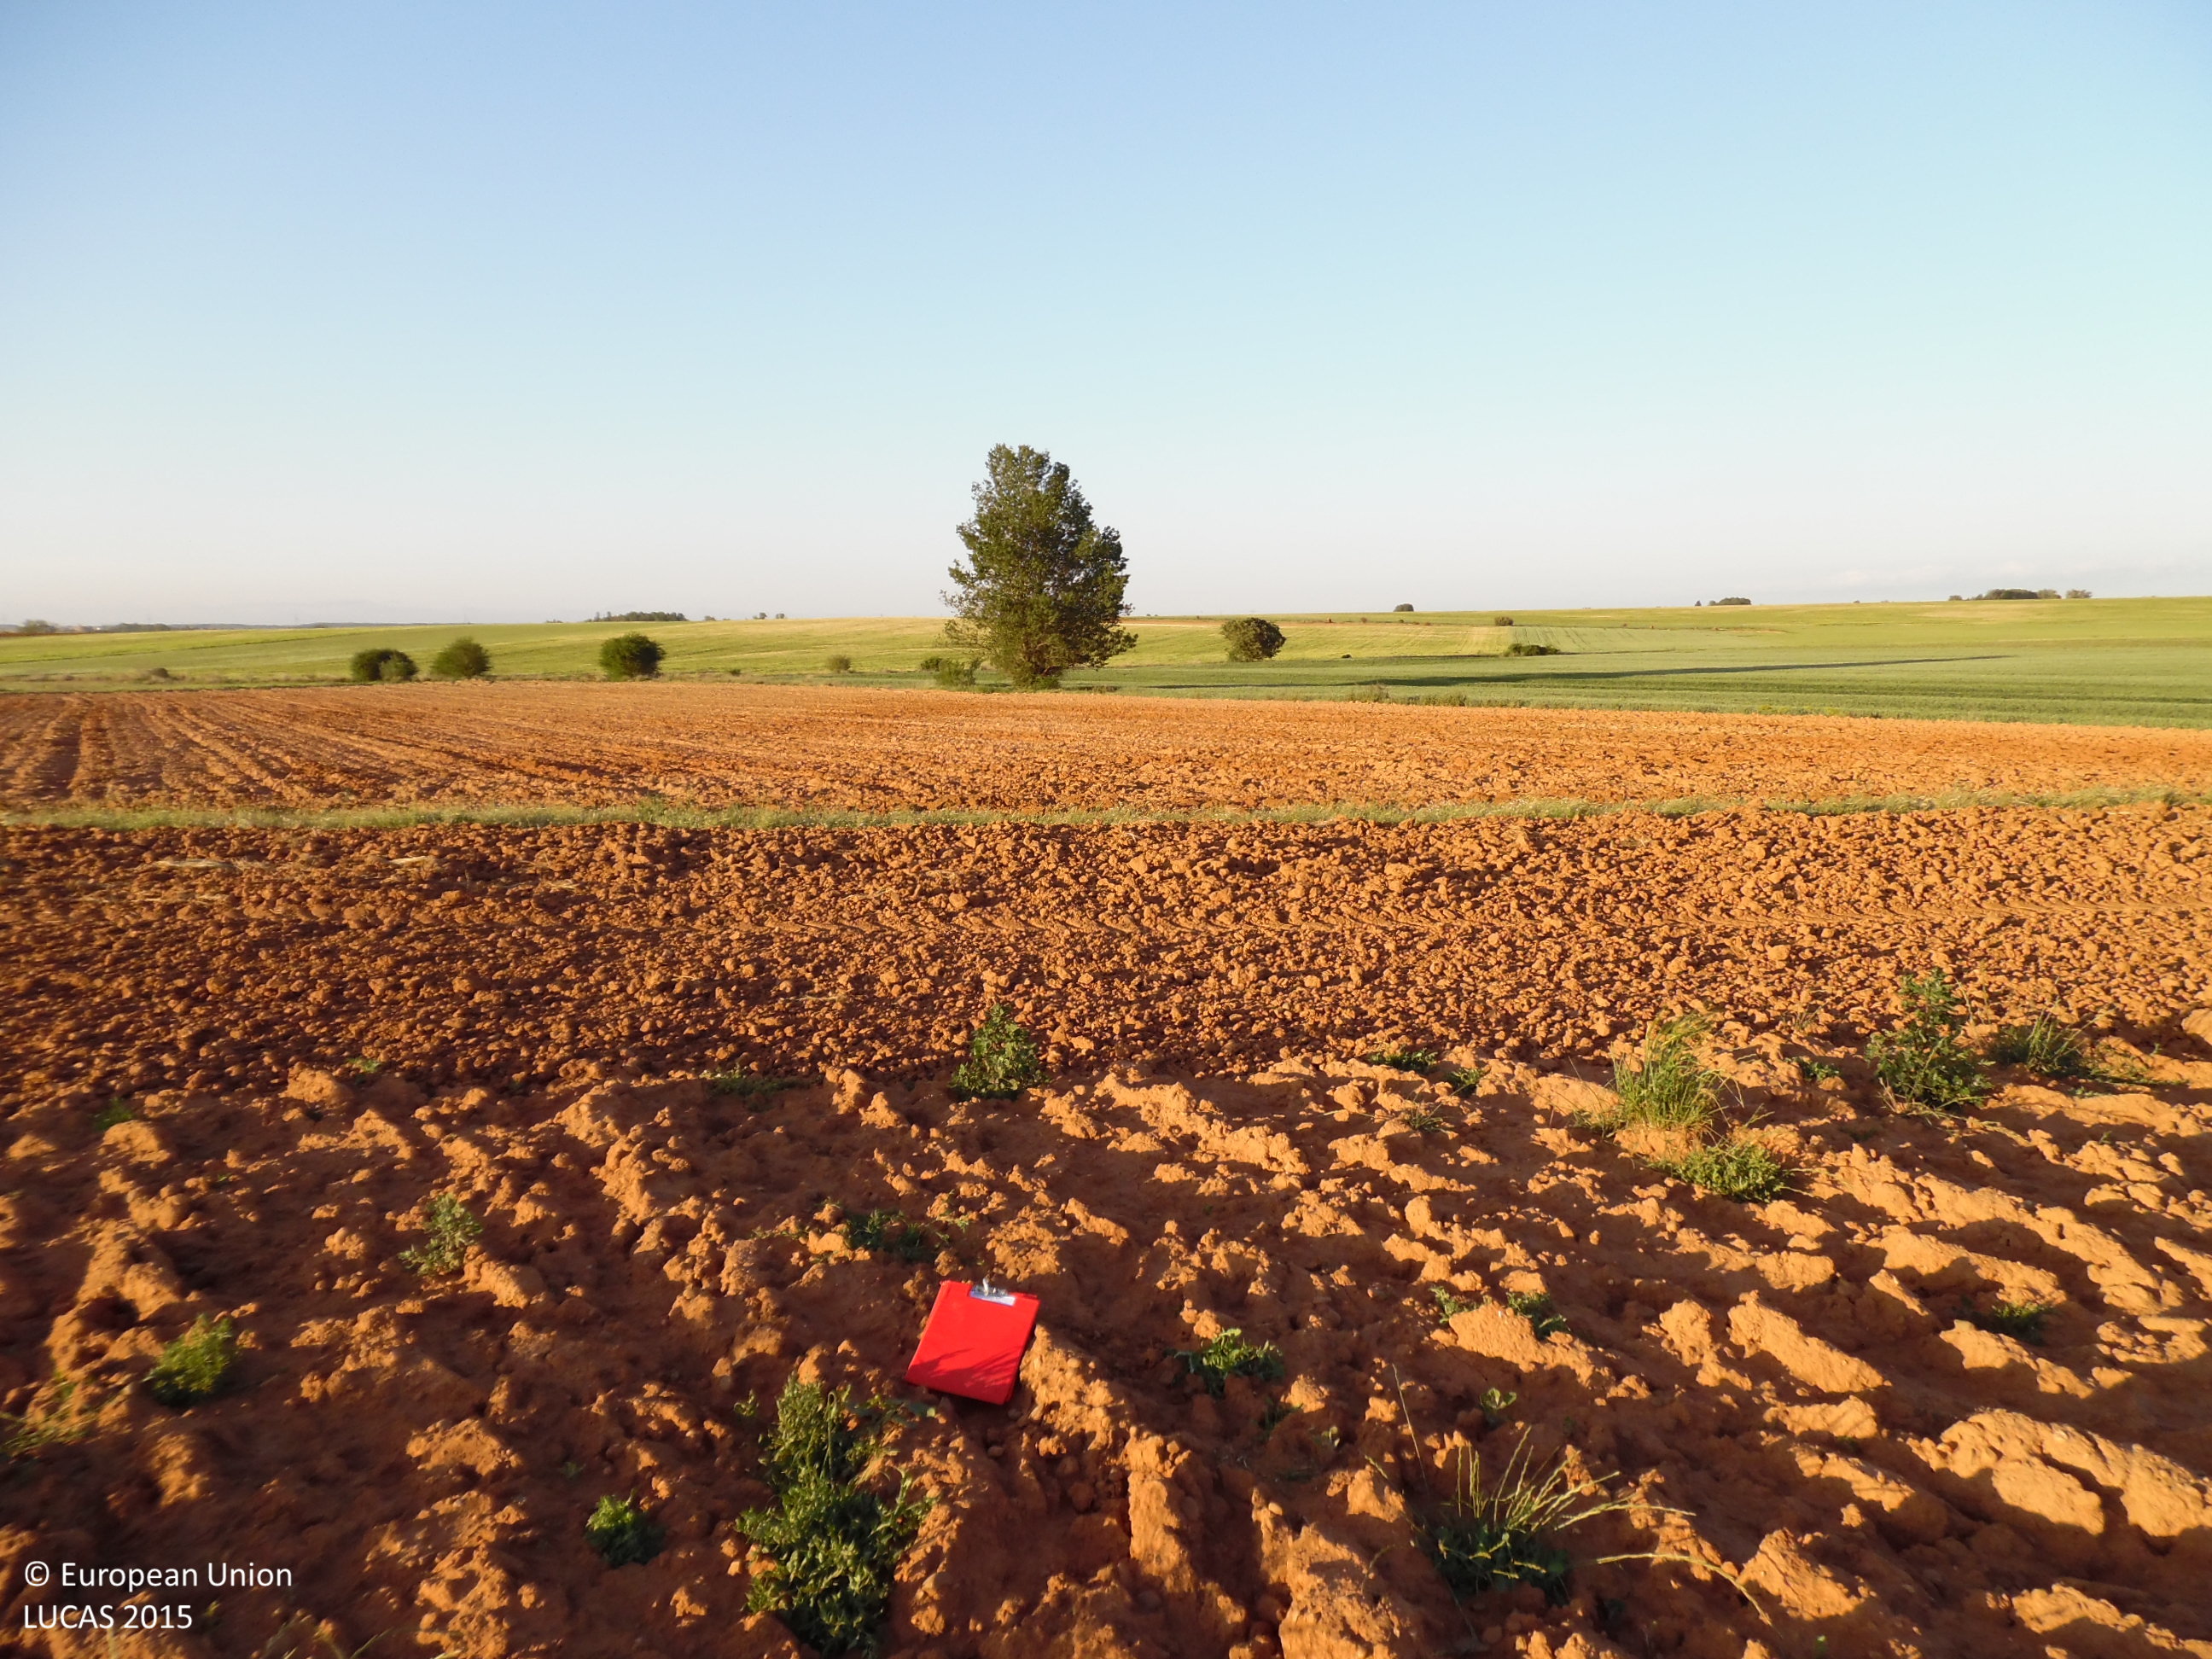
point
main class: Grassland
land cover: Spontaneously vegetated surfaces
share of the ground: 10 - 25 %
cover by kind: herbaceous plants 50 %, unconsolidated bare surface 50 %
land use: Fallow land
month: May
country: ES
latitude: 42.1562
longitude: -5.6942
